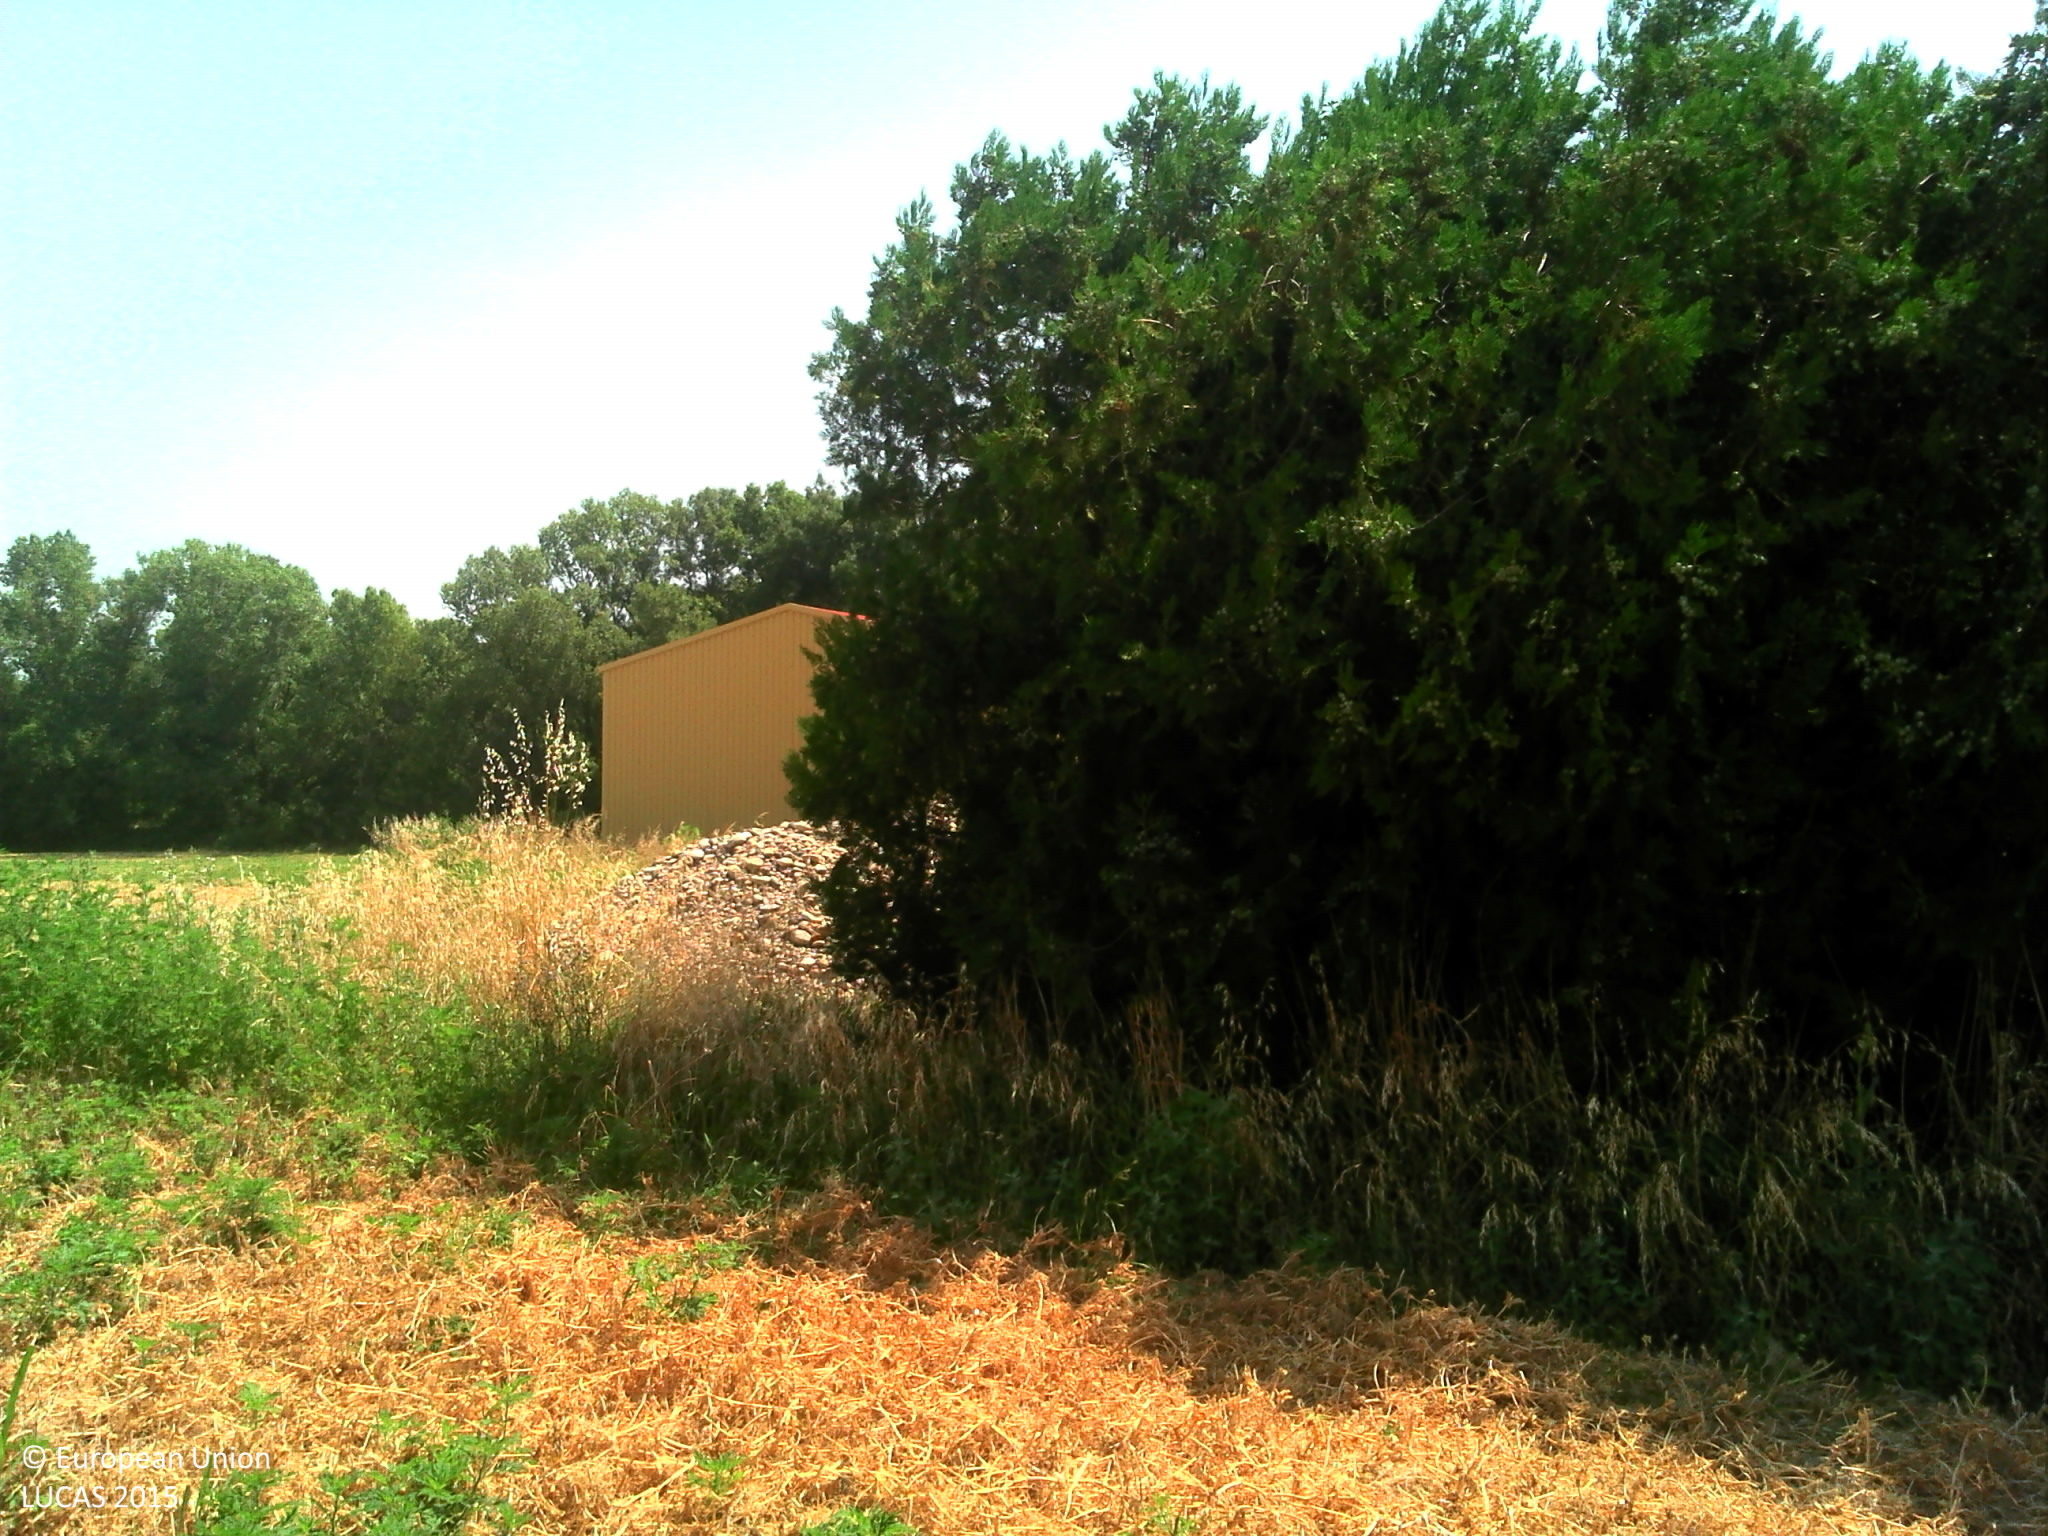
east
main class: Cropland
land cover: Dry pulses
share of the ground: > 75 %
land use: Agriculture (excluding fallow land and kitchen gardens)
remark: Harvested field
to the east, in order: Dry pulses; Artificial constructions in urban areas; Broadleaved woodland; Tracks; Broadleaved woodland; Paved roads, cycling and walking lanes; Other bare soil; Broadleaved woodland; Inland fresh running water; Grassland without tree/shrub cover; Fences; Grassland without tree/shrub cover; Broadleaved woodland
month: July
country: FR
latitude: 44.4136
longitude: 4.6949
